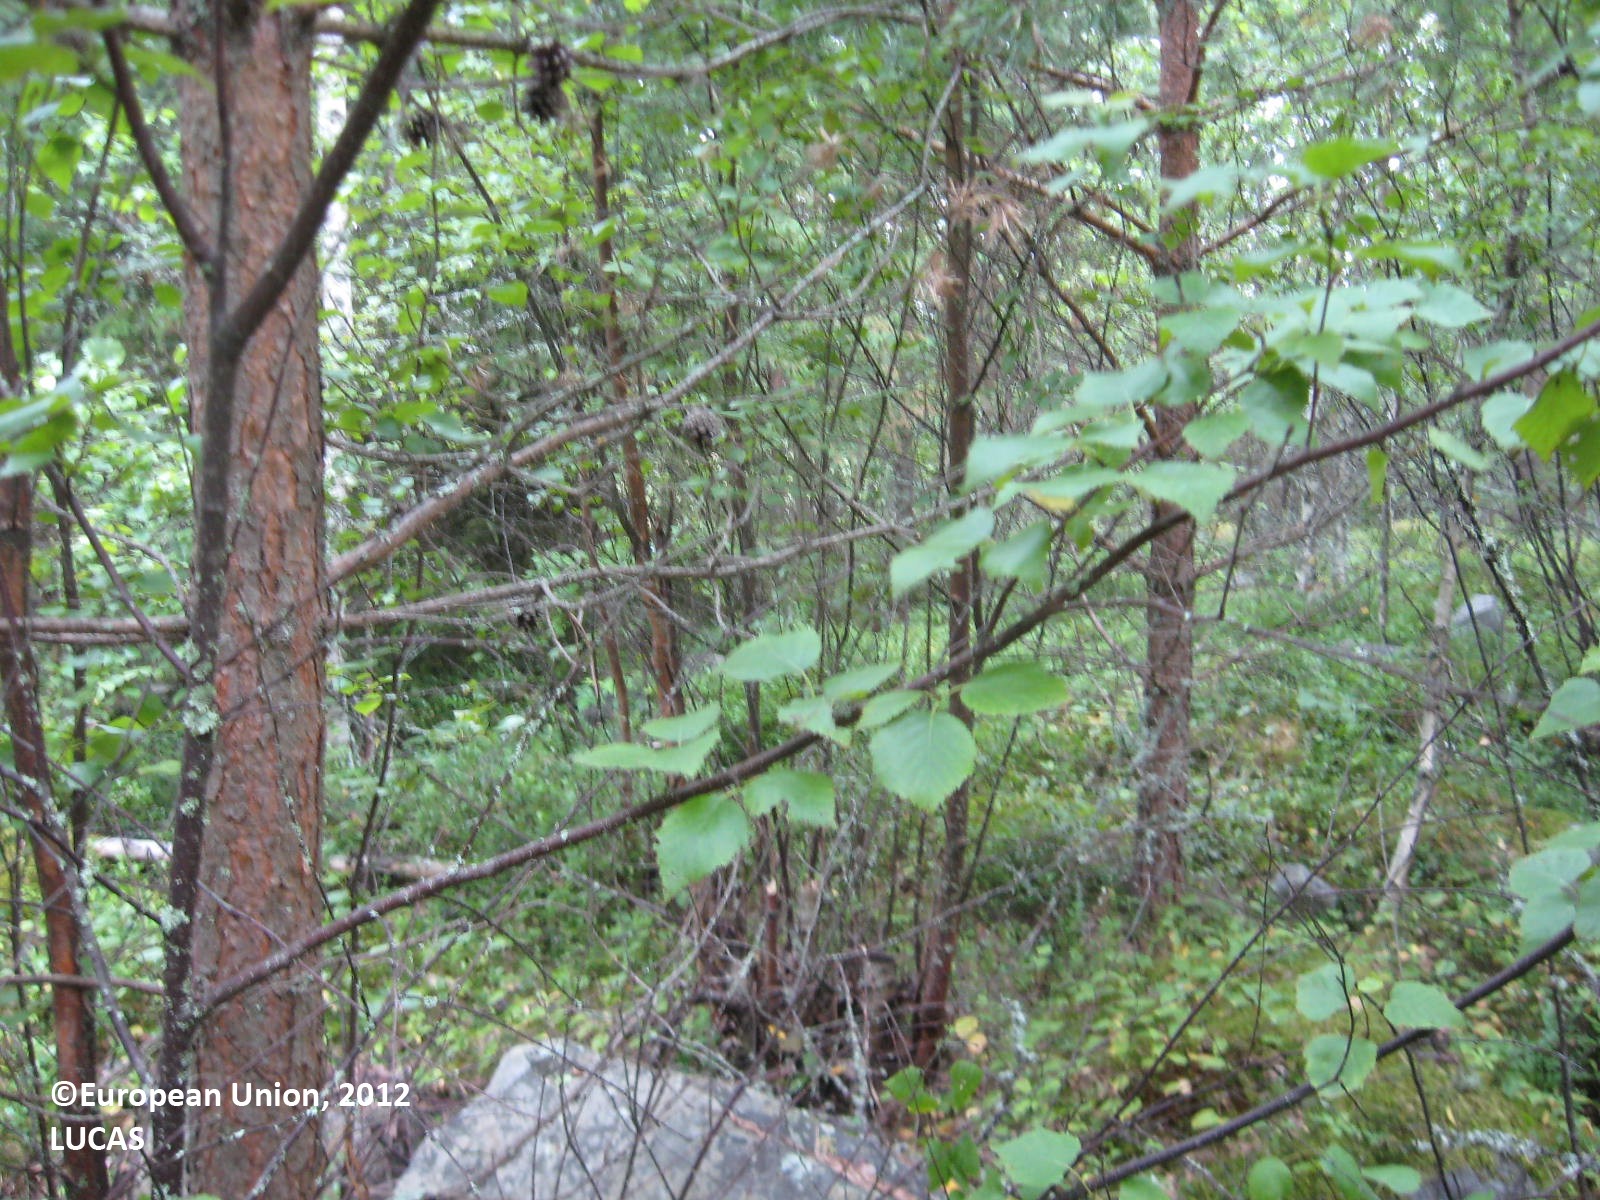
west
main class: Woodland
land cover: Other mixed woodland
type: boreal forest
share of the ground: > 75 %
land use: Forestry
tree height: > 5 m
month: July
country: FI
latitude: 61.8800
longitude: 21.4780
